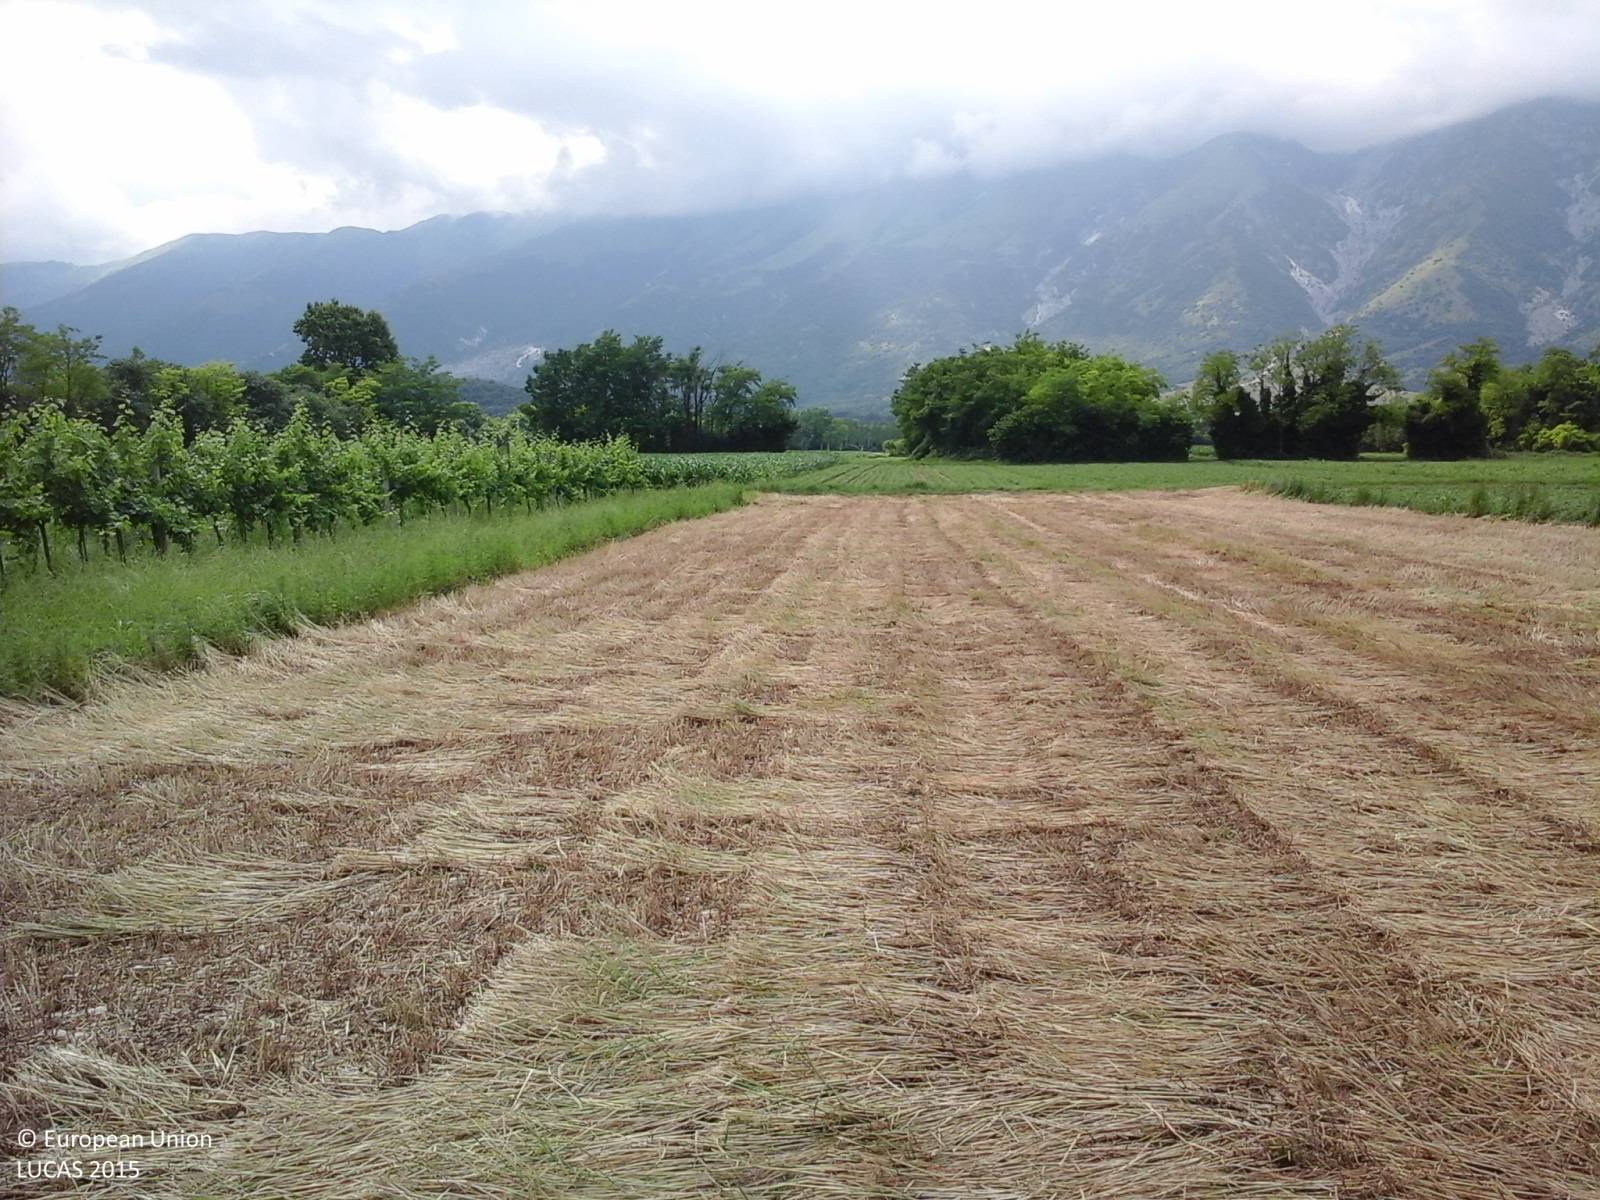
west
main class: Cropland
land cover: Common wheat
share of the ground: > 75 %
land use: Agriculture (excluding fallow land and kitchen gardens)
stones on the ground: > 50 %
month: June
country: IT
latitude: 46.1202
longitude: 12.6496
